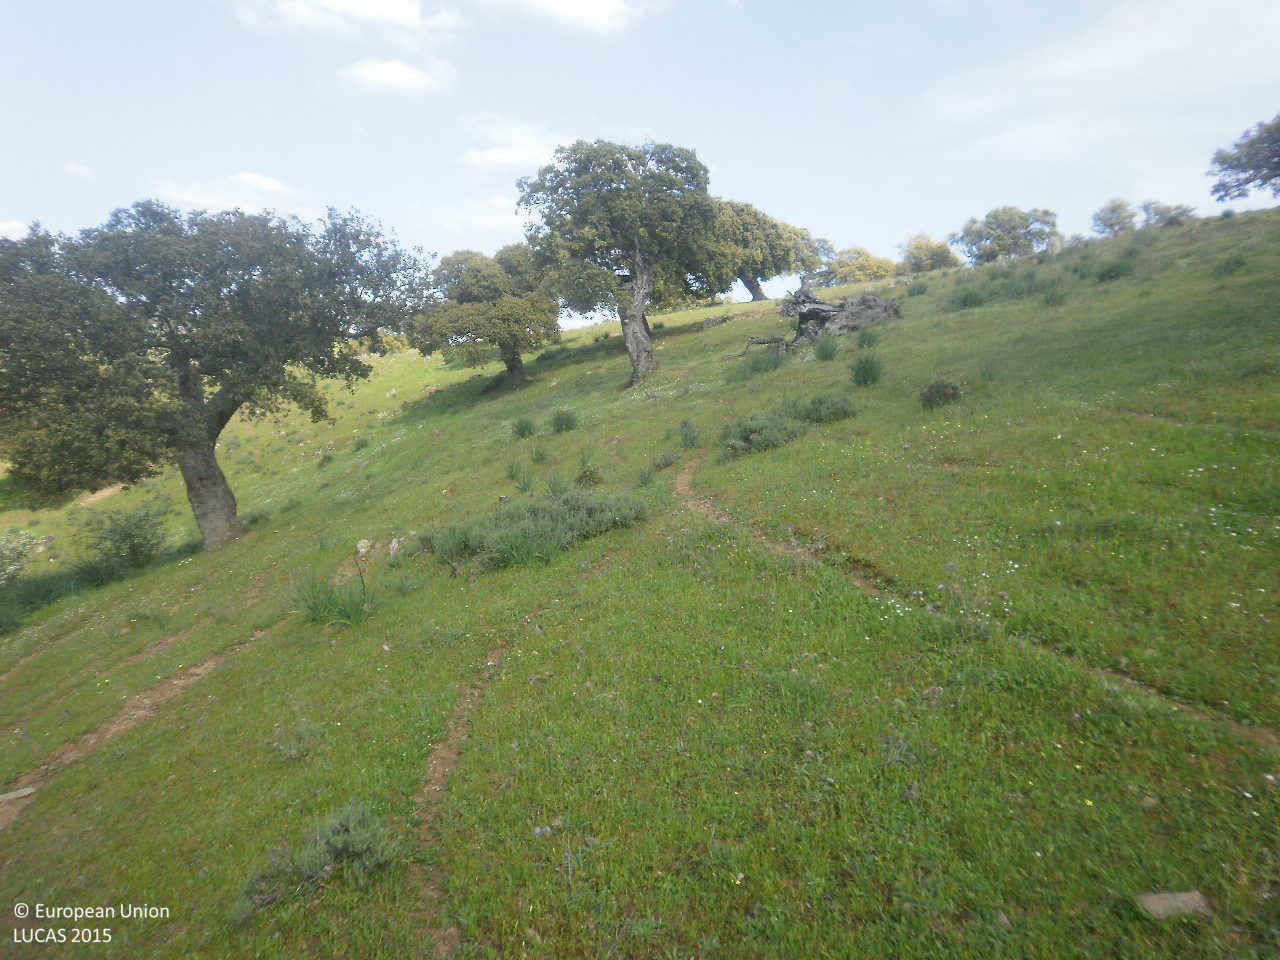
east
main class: Grassland
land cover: Grassland with sparse tree/shrub cover
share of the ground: > 75 %
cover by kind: herbaceous plants 85 %, shrubs 10 %, broadleaved forest trees 5 %
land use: Agriculture (excluding fallow land and kitchen gardens)
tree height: > 5 m
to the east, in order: Grassland with sparse tree/shrub cover; Broadleaved woodland; Fences; Grassland with sparse tree/shrub cover
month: April
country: ES
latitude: 38.9876
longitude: -5.1733
